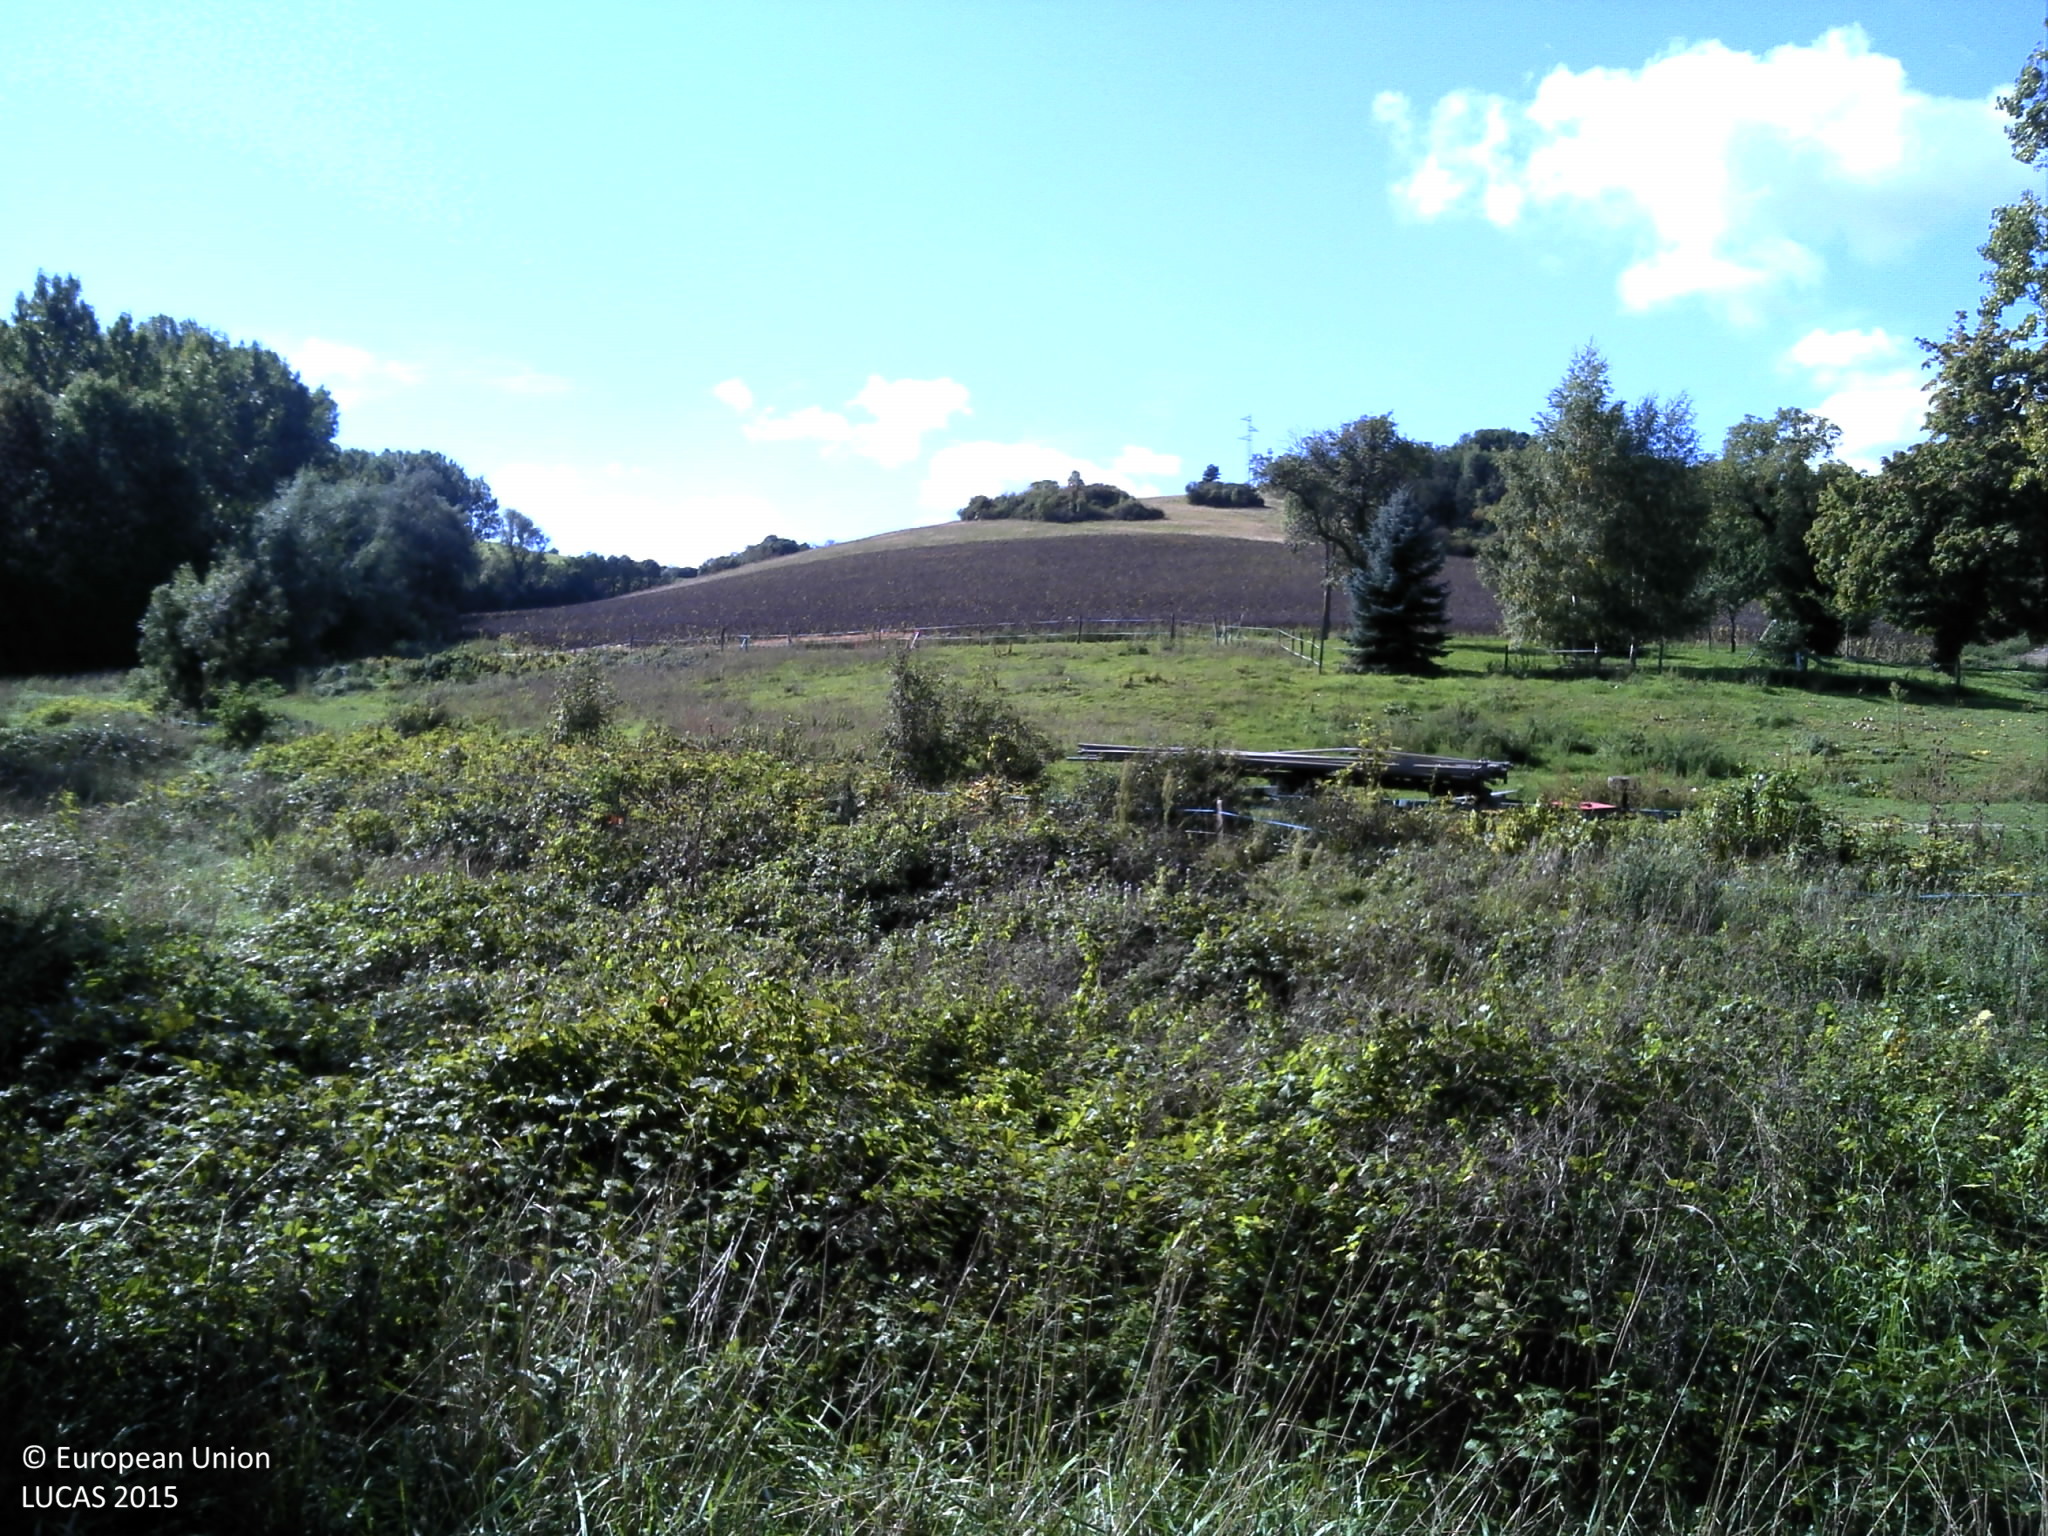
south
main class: Grassland
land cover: Grassland without tree/shrub cover
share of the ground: > 75 %
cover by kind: herbaceous plants 95 %, shrubs 5 %
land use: Agriculture (excluding fallow land and kitchen gardens)
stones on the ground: < 10 %
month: September
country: FR
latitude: 45.5675
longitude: 3.0942
